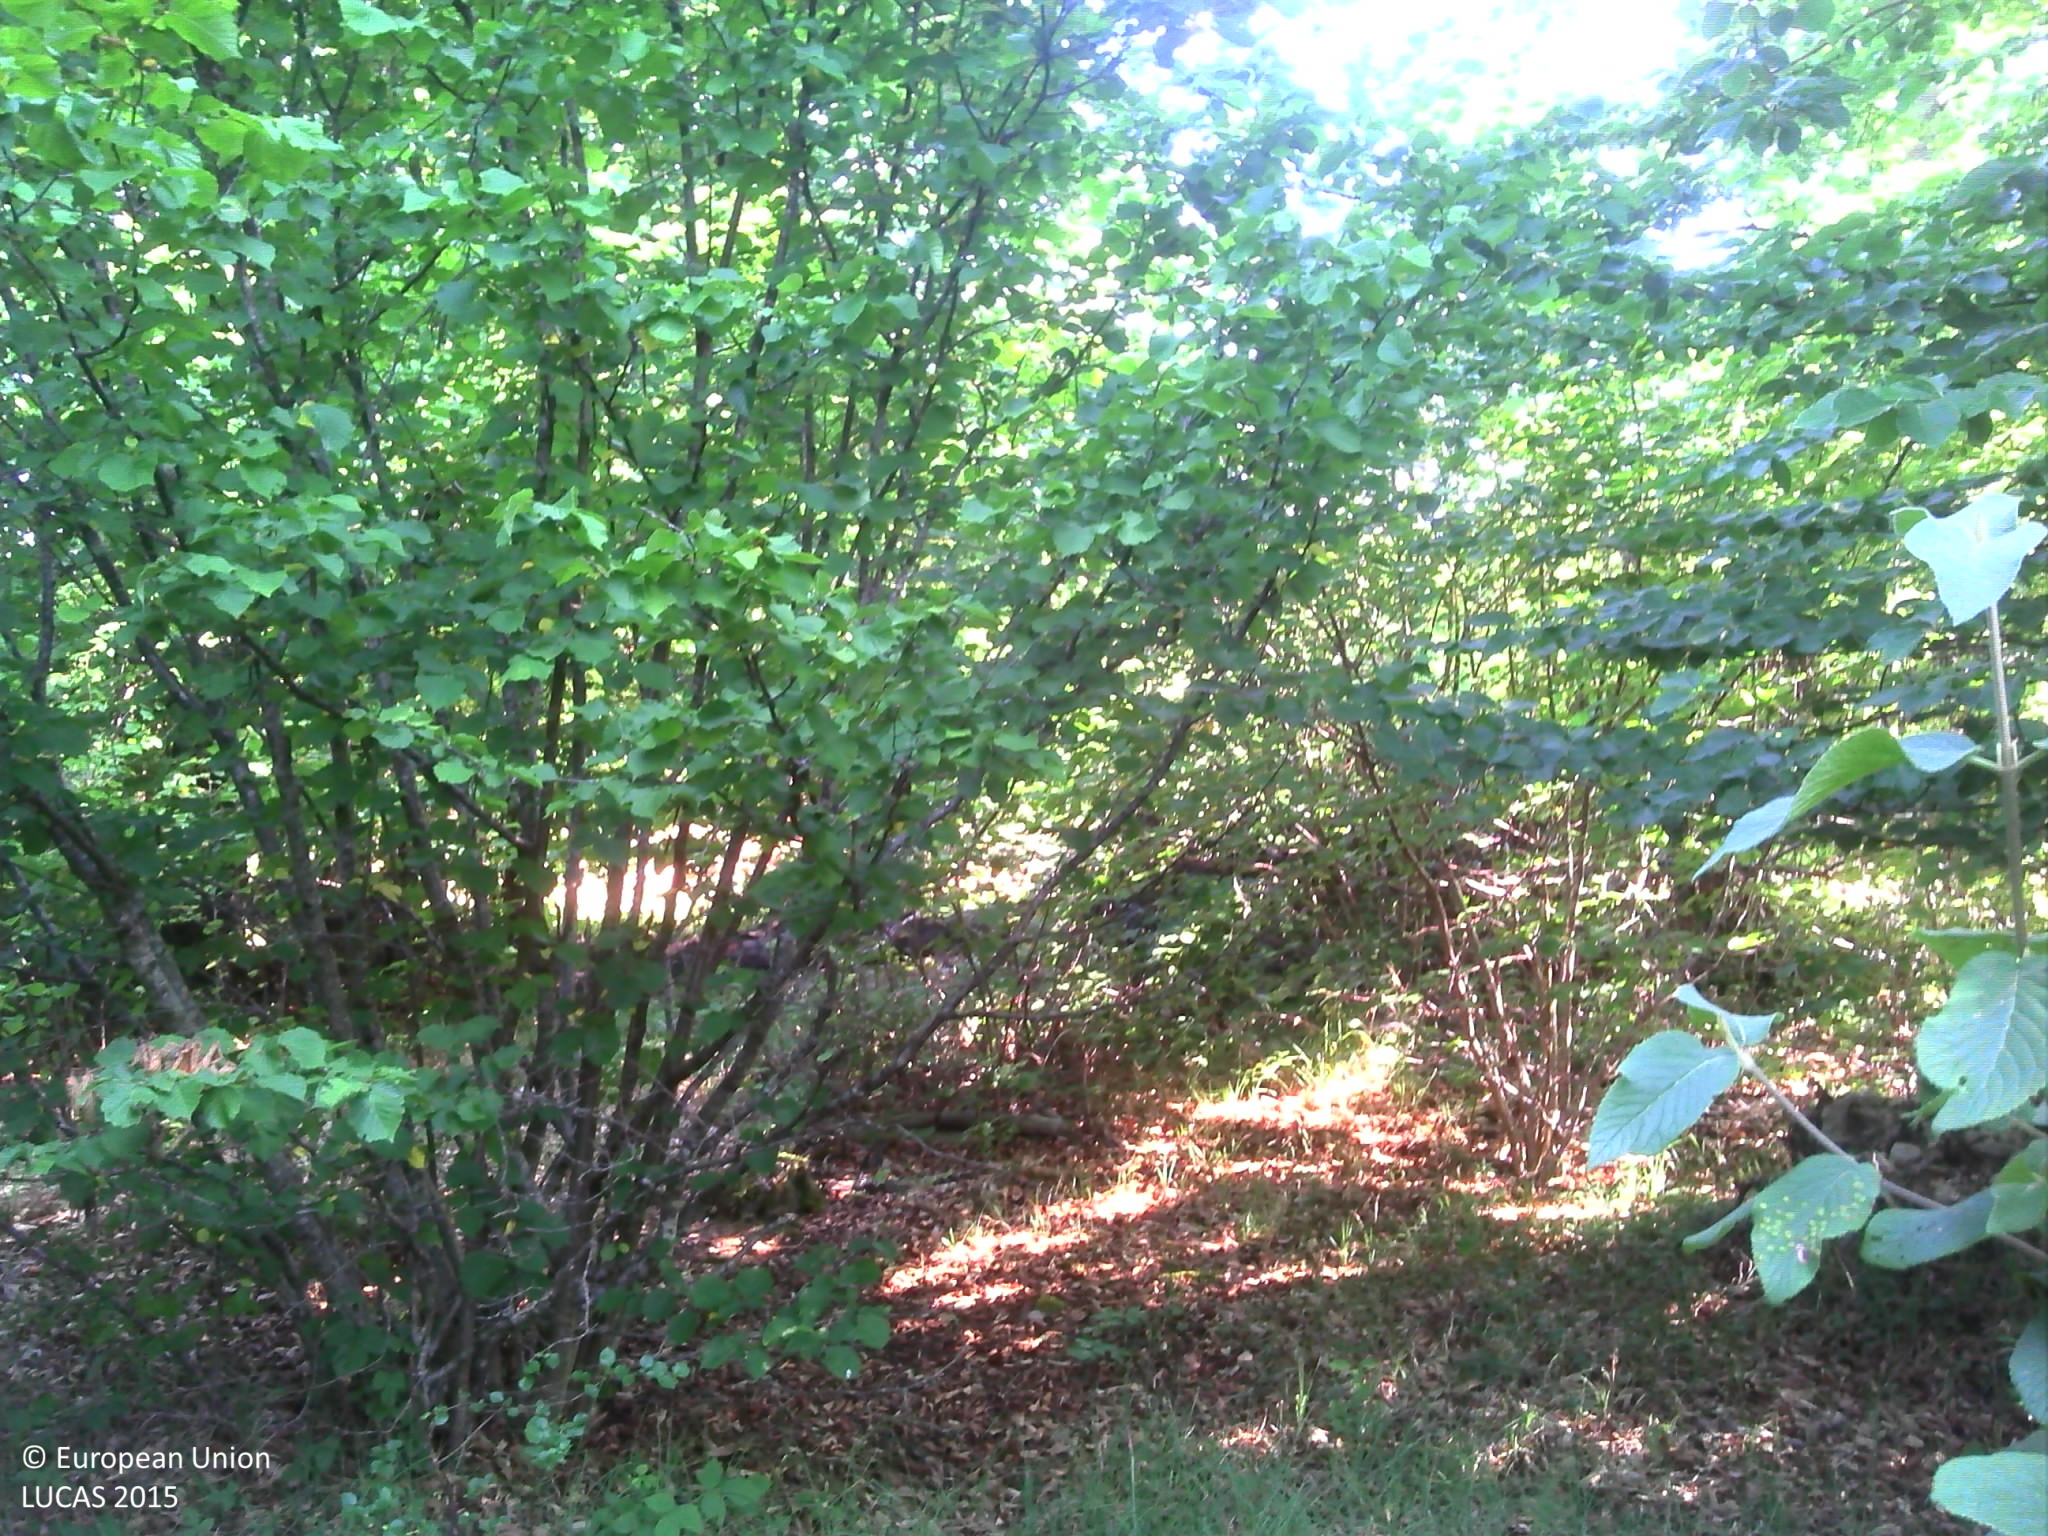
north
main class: Woodland
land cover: Broadleaved woodland
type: beech forest
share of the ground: > 75 %
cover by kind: broadleaved forest trees 80 %, herbaceous plants 10 %, coniferous forest trees 5 %, lichens and mosses 5 %
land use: Forestry
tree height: > 5 m
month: July
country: FR
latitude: 48.0701
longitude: 4.9124
